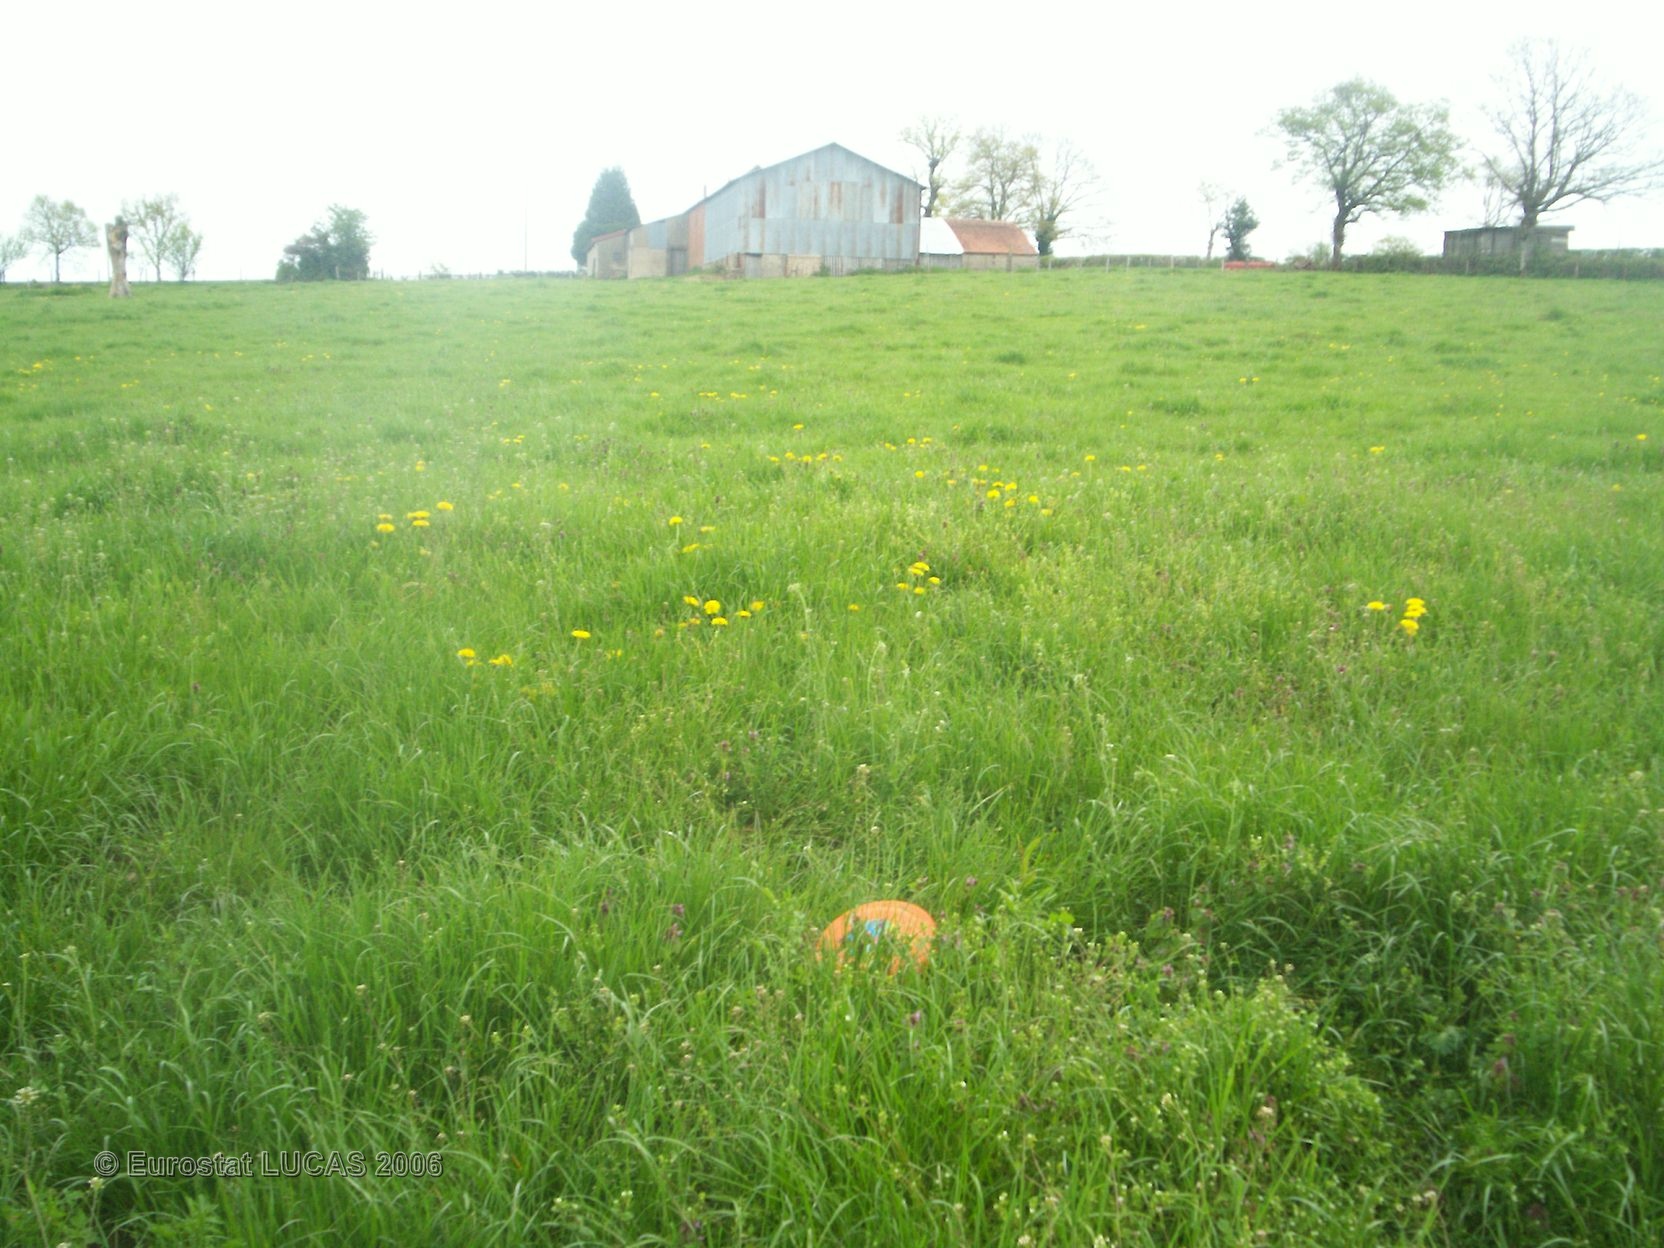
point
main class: Grassland
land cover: Grassland with sparse tree/shrub cover
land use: Agriculture (excluding fallow land and kitchen gardens)
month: May
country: FR
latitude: 46.4184
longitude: 3.1151
